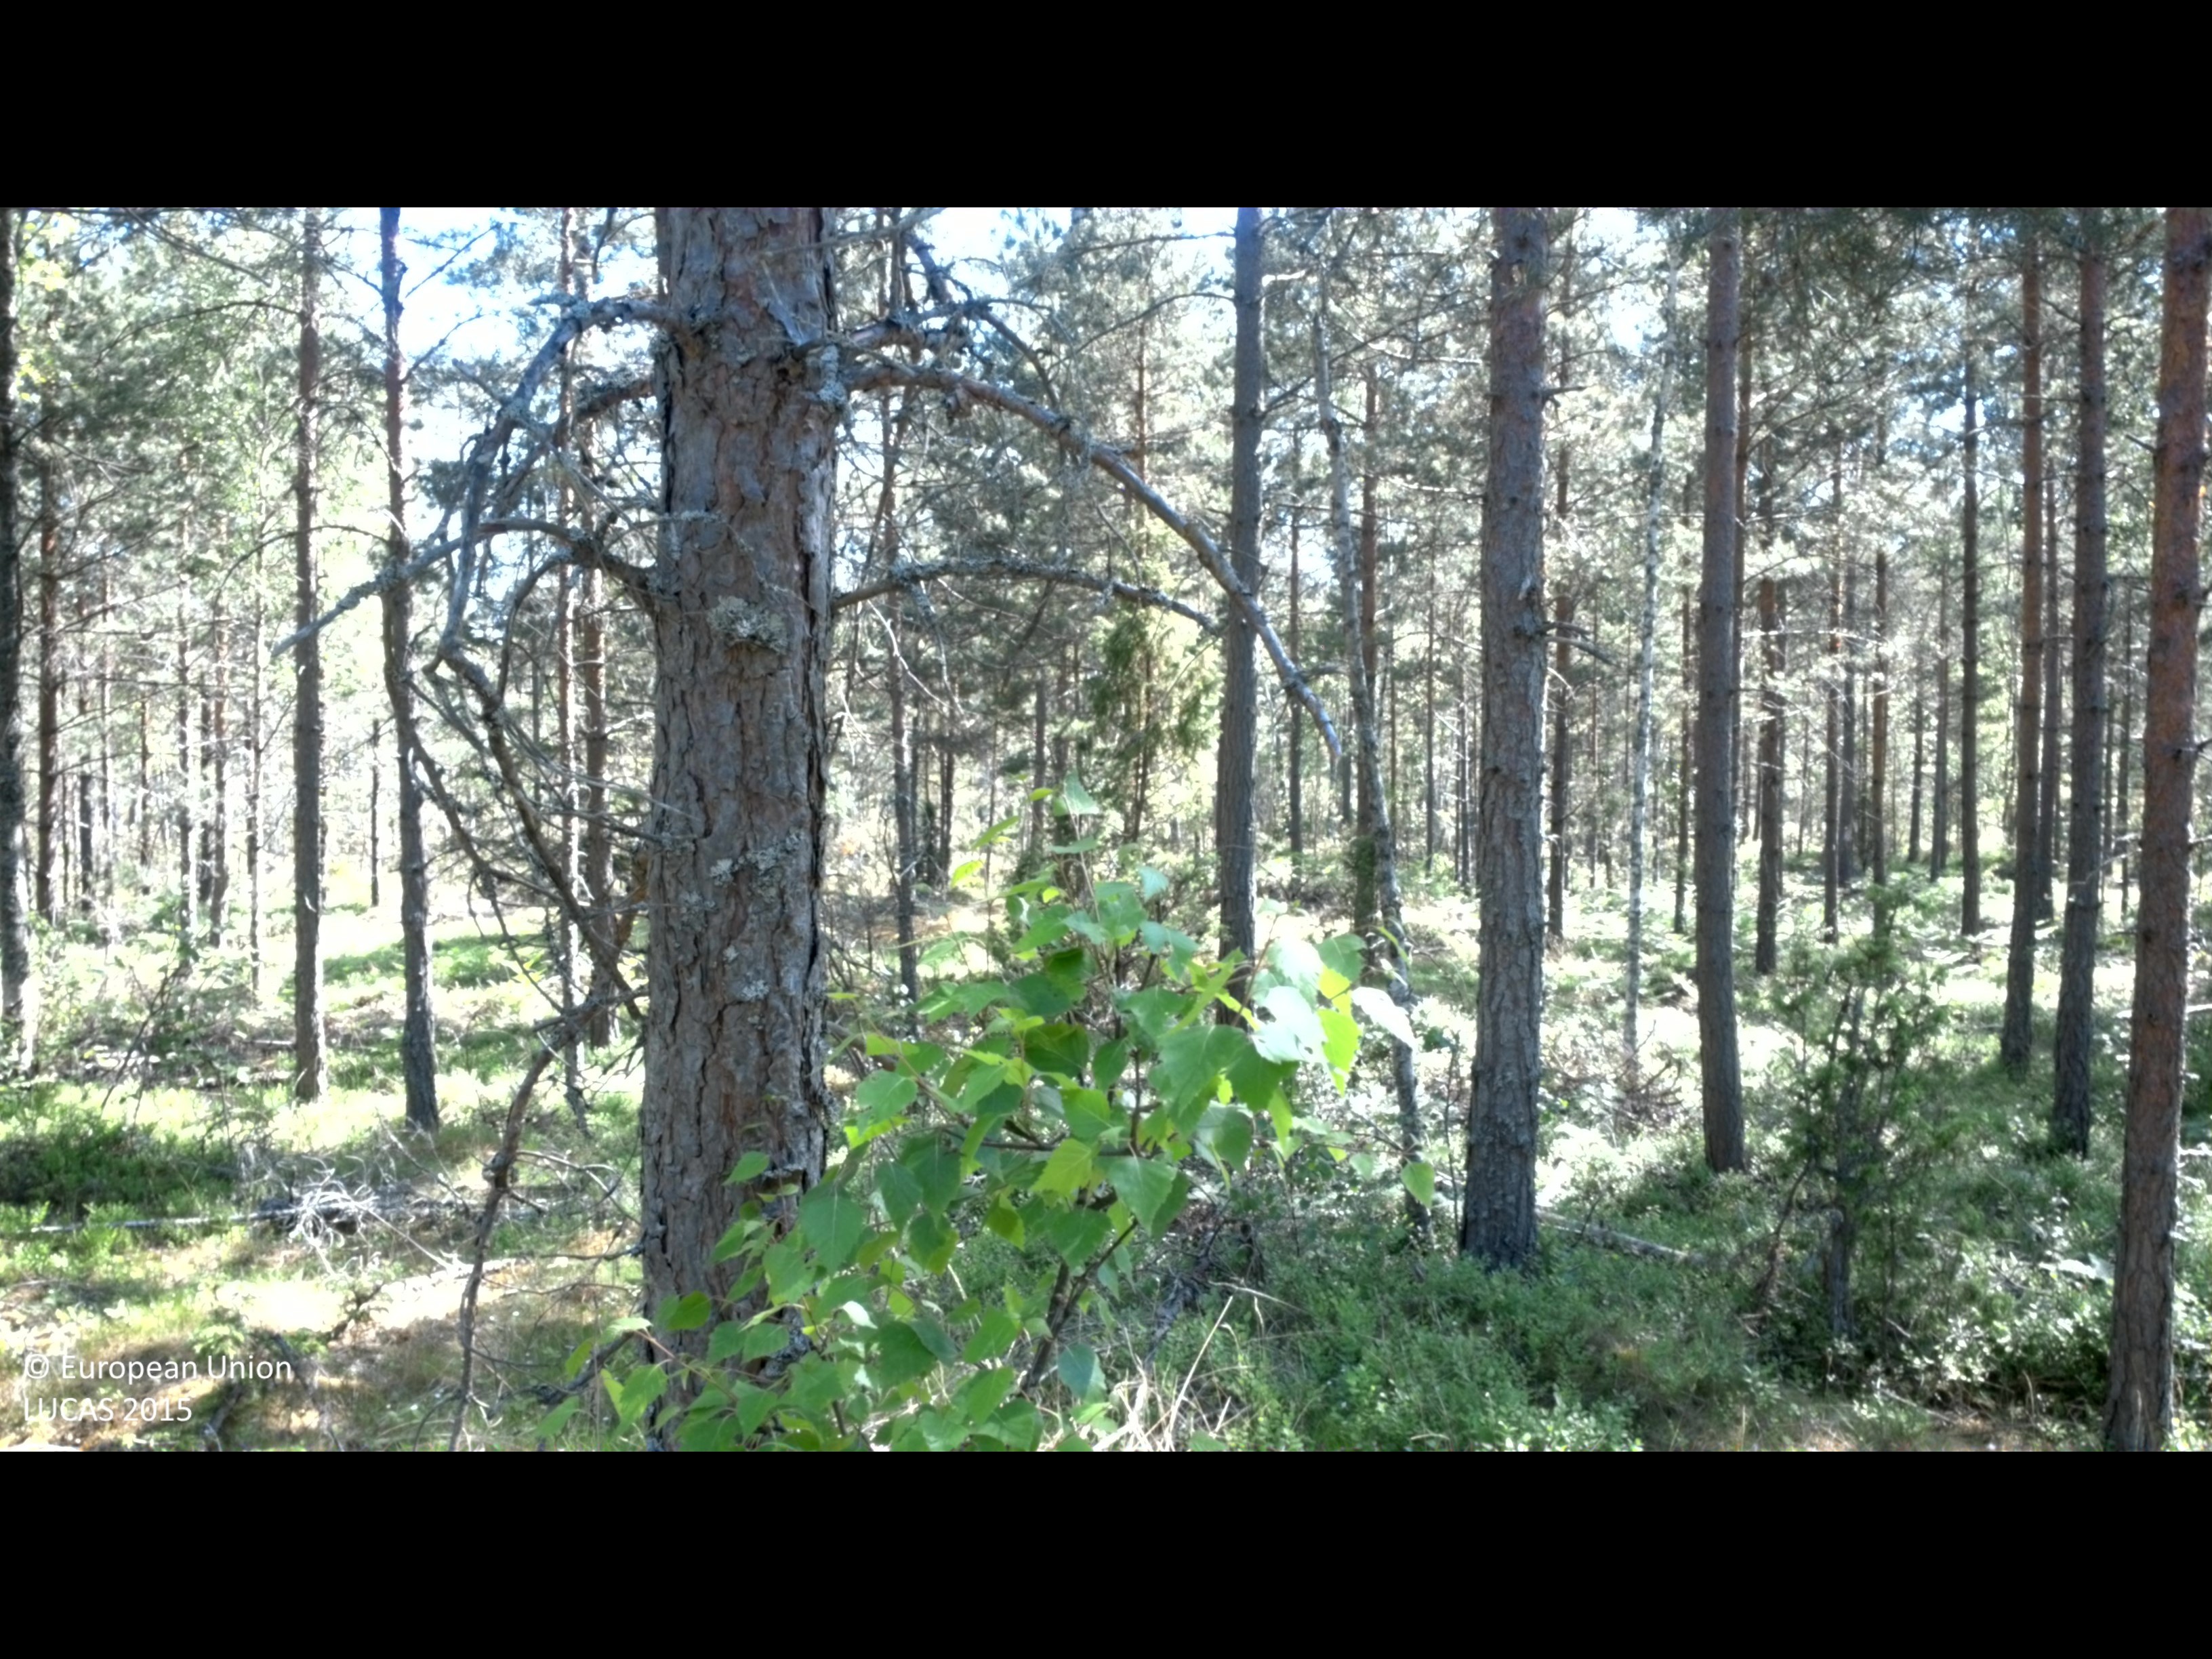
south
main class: Woodland
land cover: Pine dominated coniferous woodland
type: boreal forest
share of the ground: 50 - 75 %
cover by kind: coniferous forest trees 60 %, shrubs 20 %, herbaceous plants 10 %, broadleaved forest trees 5 %, lichens and mosses 5 %
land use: Forestry
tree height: > 5 m
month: June
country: SE
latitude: 57.6414
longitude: 16.6162
